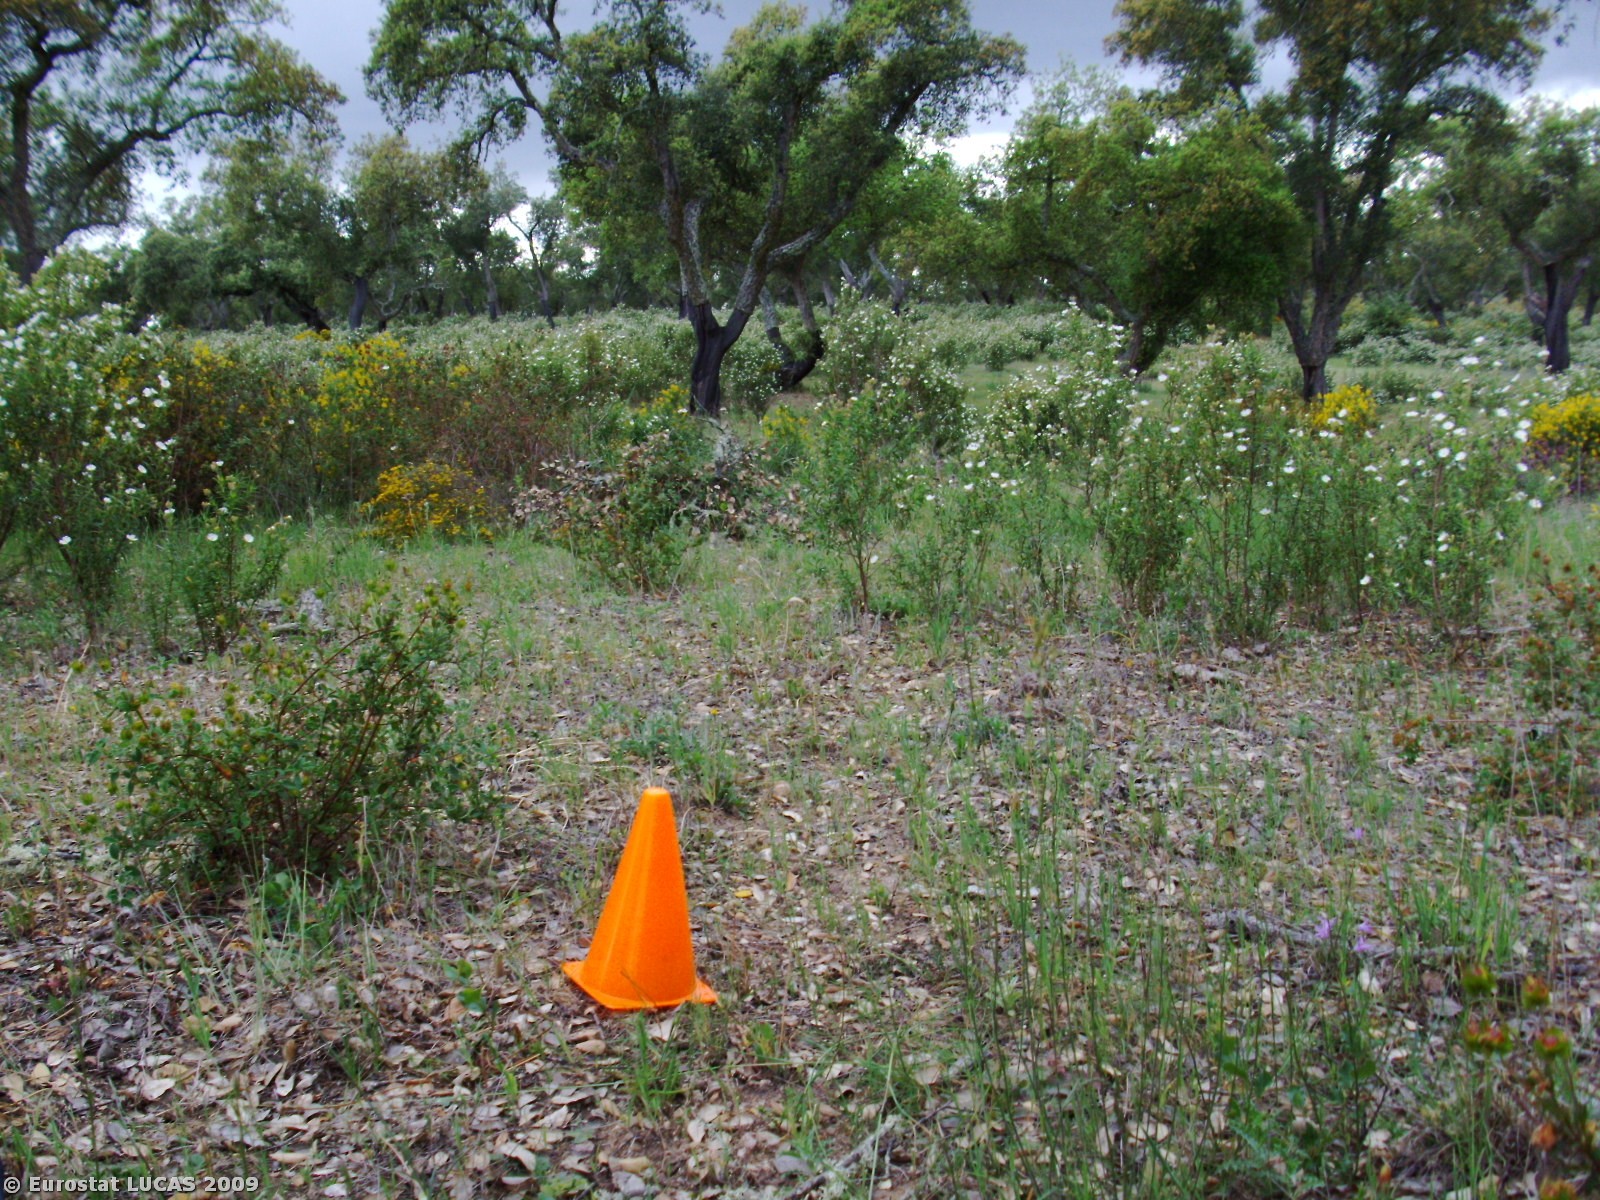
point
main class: Woodland
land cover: Broadleaved woodland
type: broadleaved evergreen forest
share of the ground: 25 - 50 %
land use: Forestry
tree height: > 5 m
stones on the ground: 25 - 50 %
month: April
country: PT
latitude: 38.5305
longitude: -7.7112
